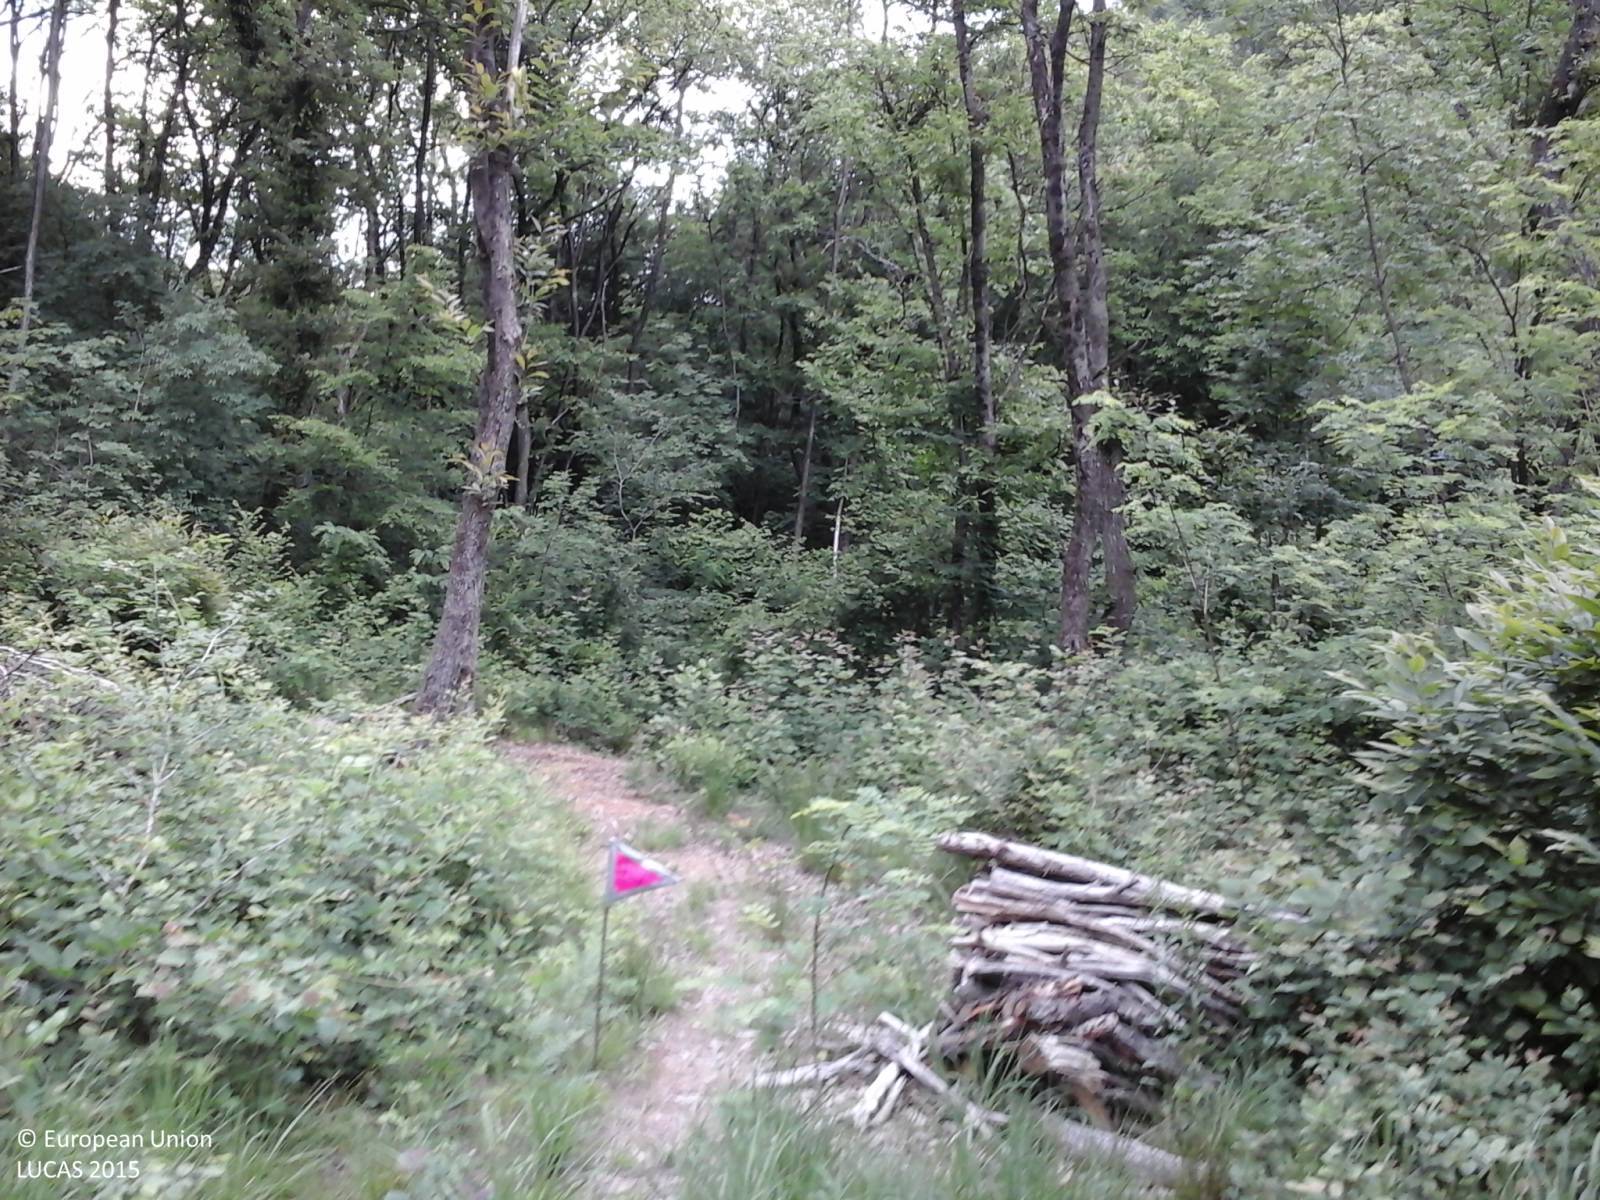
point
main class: Woodland
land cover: Broadleaved woodland
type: mesophytic deciduous forest
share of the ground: > 75 %
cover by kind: broadleaved forest trees 85 %, shrubs 10 %, herbaceous plants 5 %
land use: Forestry
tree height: > 5 m
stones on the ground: 25 - 50 %
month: May
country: IT
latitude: 46.1749
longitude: 13.2737
